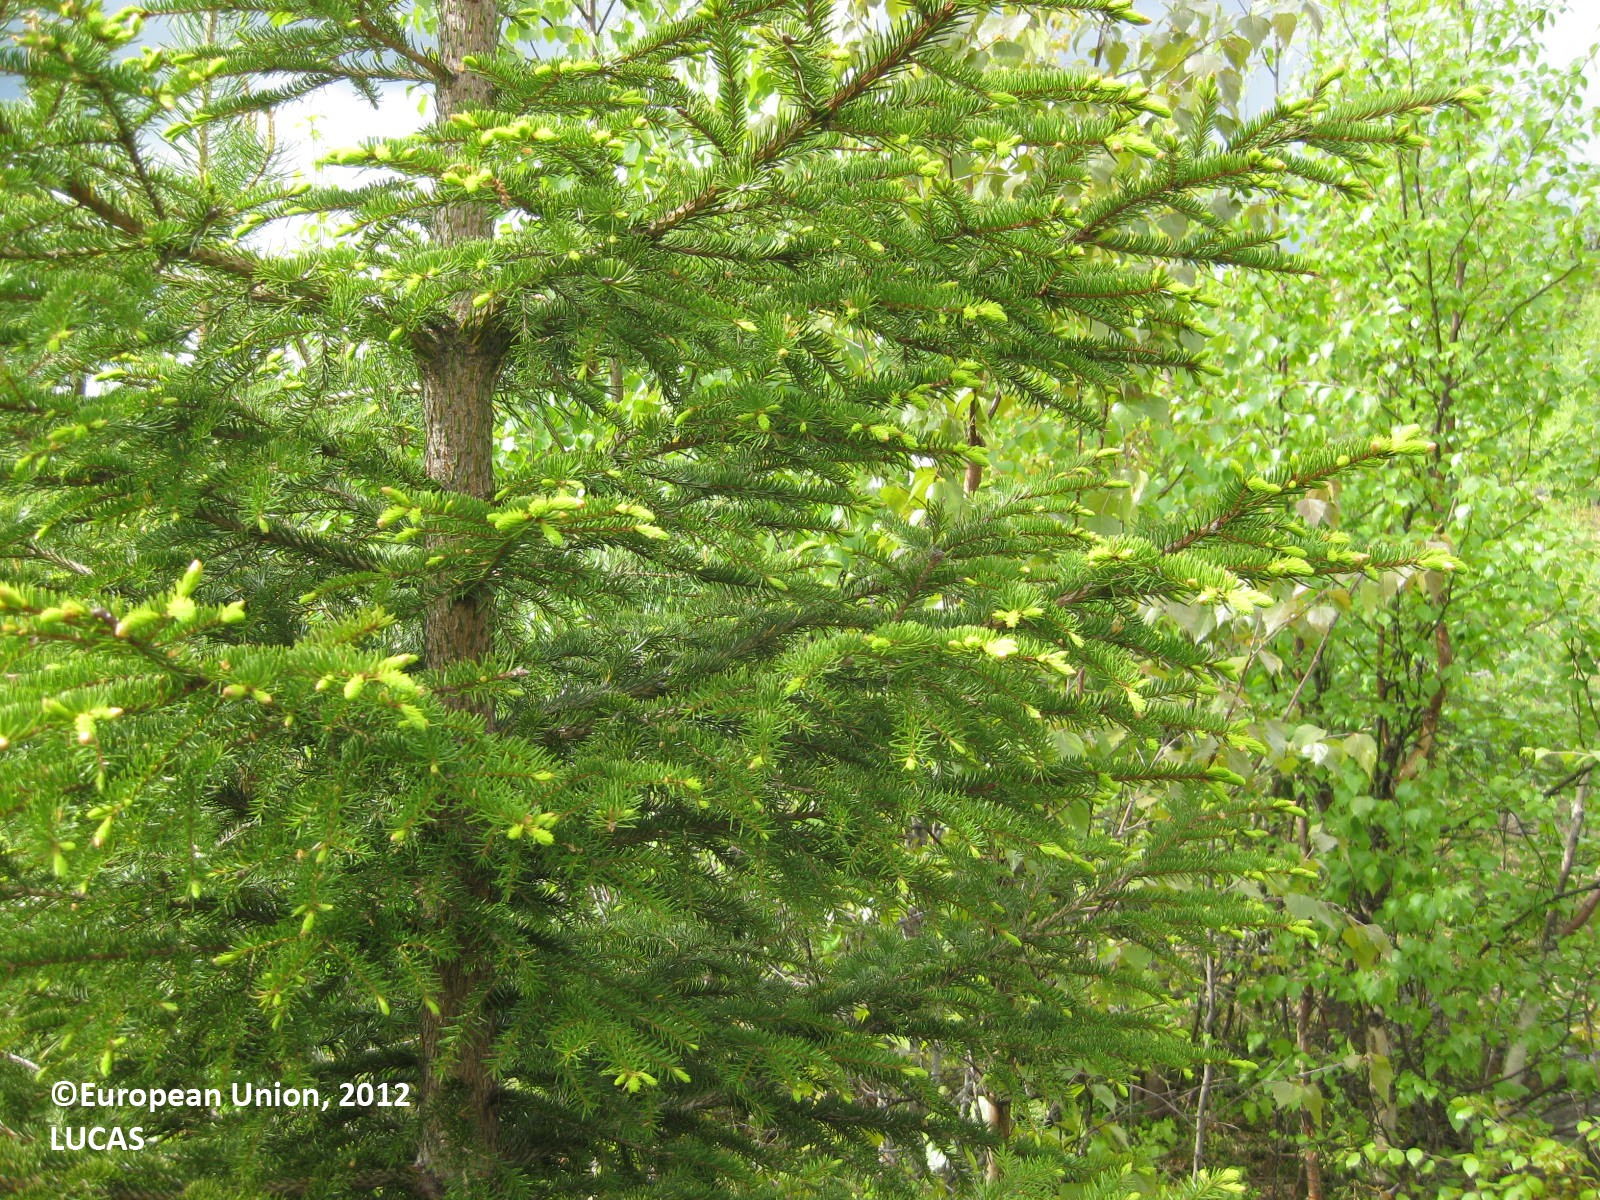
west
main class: Woodland
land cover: Broadleaved woodland
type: boreal forest
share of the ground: 50 - 75 %
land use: Forestry
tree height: > 5 m
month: June
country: FI
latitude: 65.1894
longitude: 28.9118
